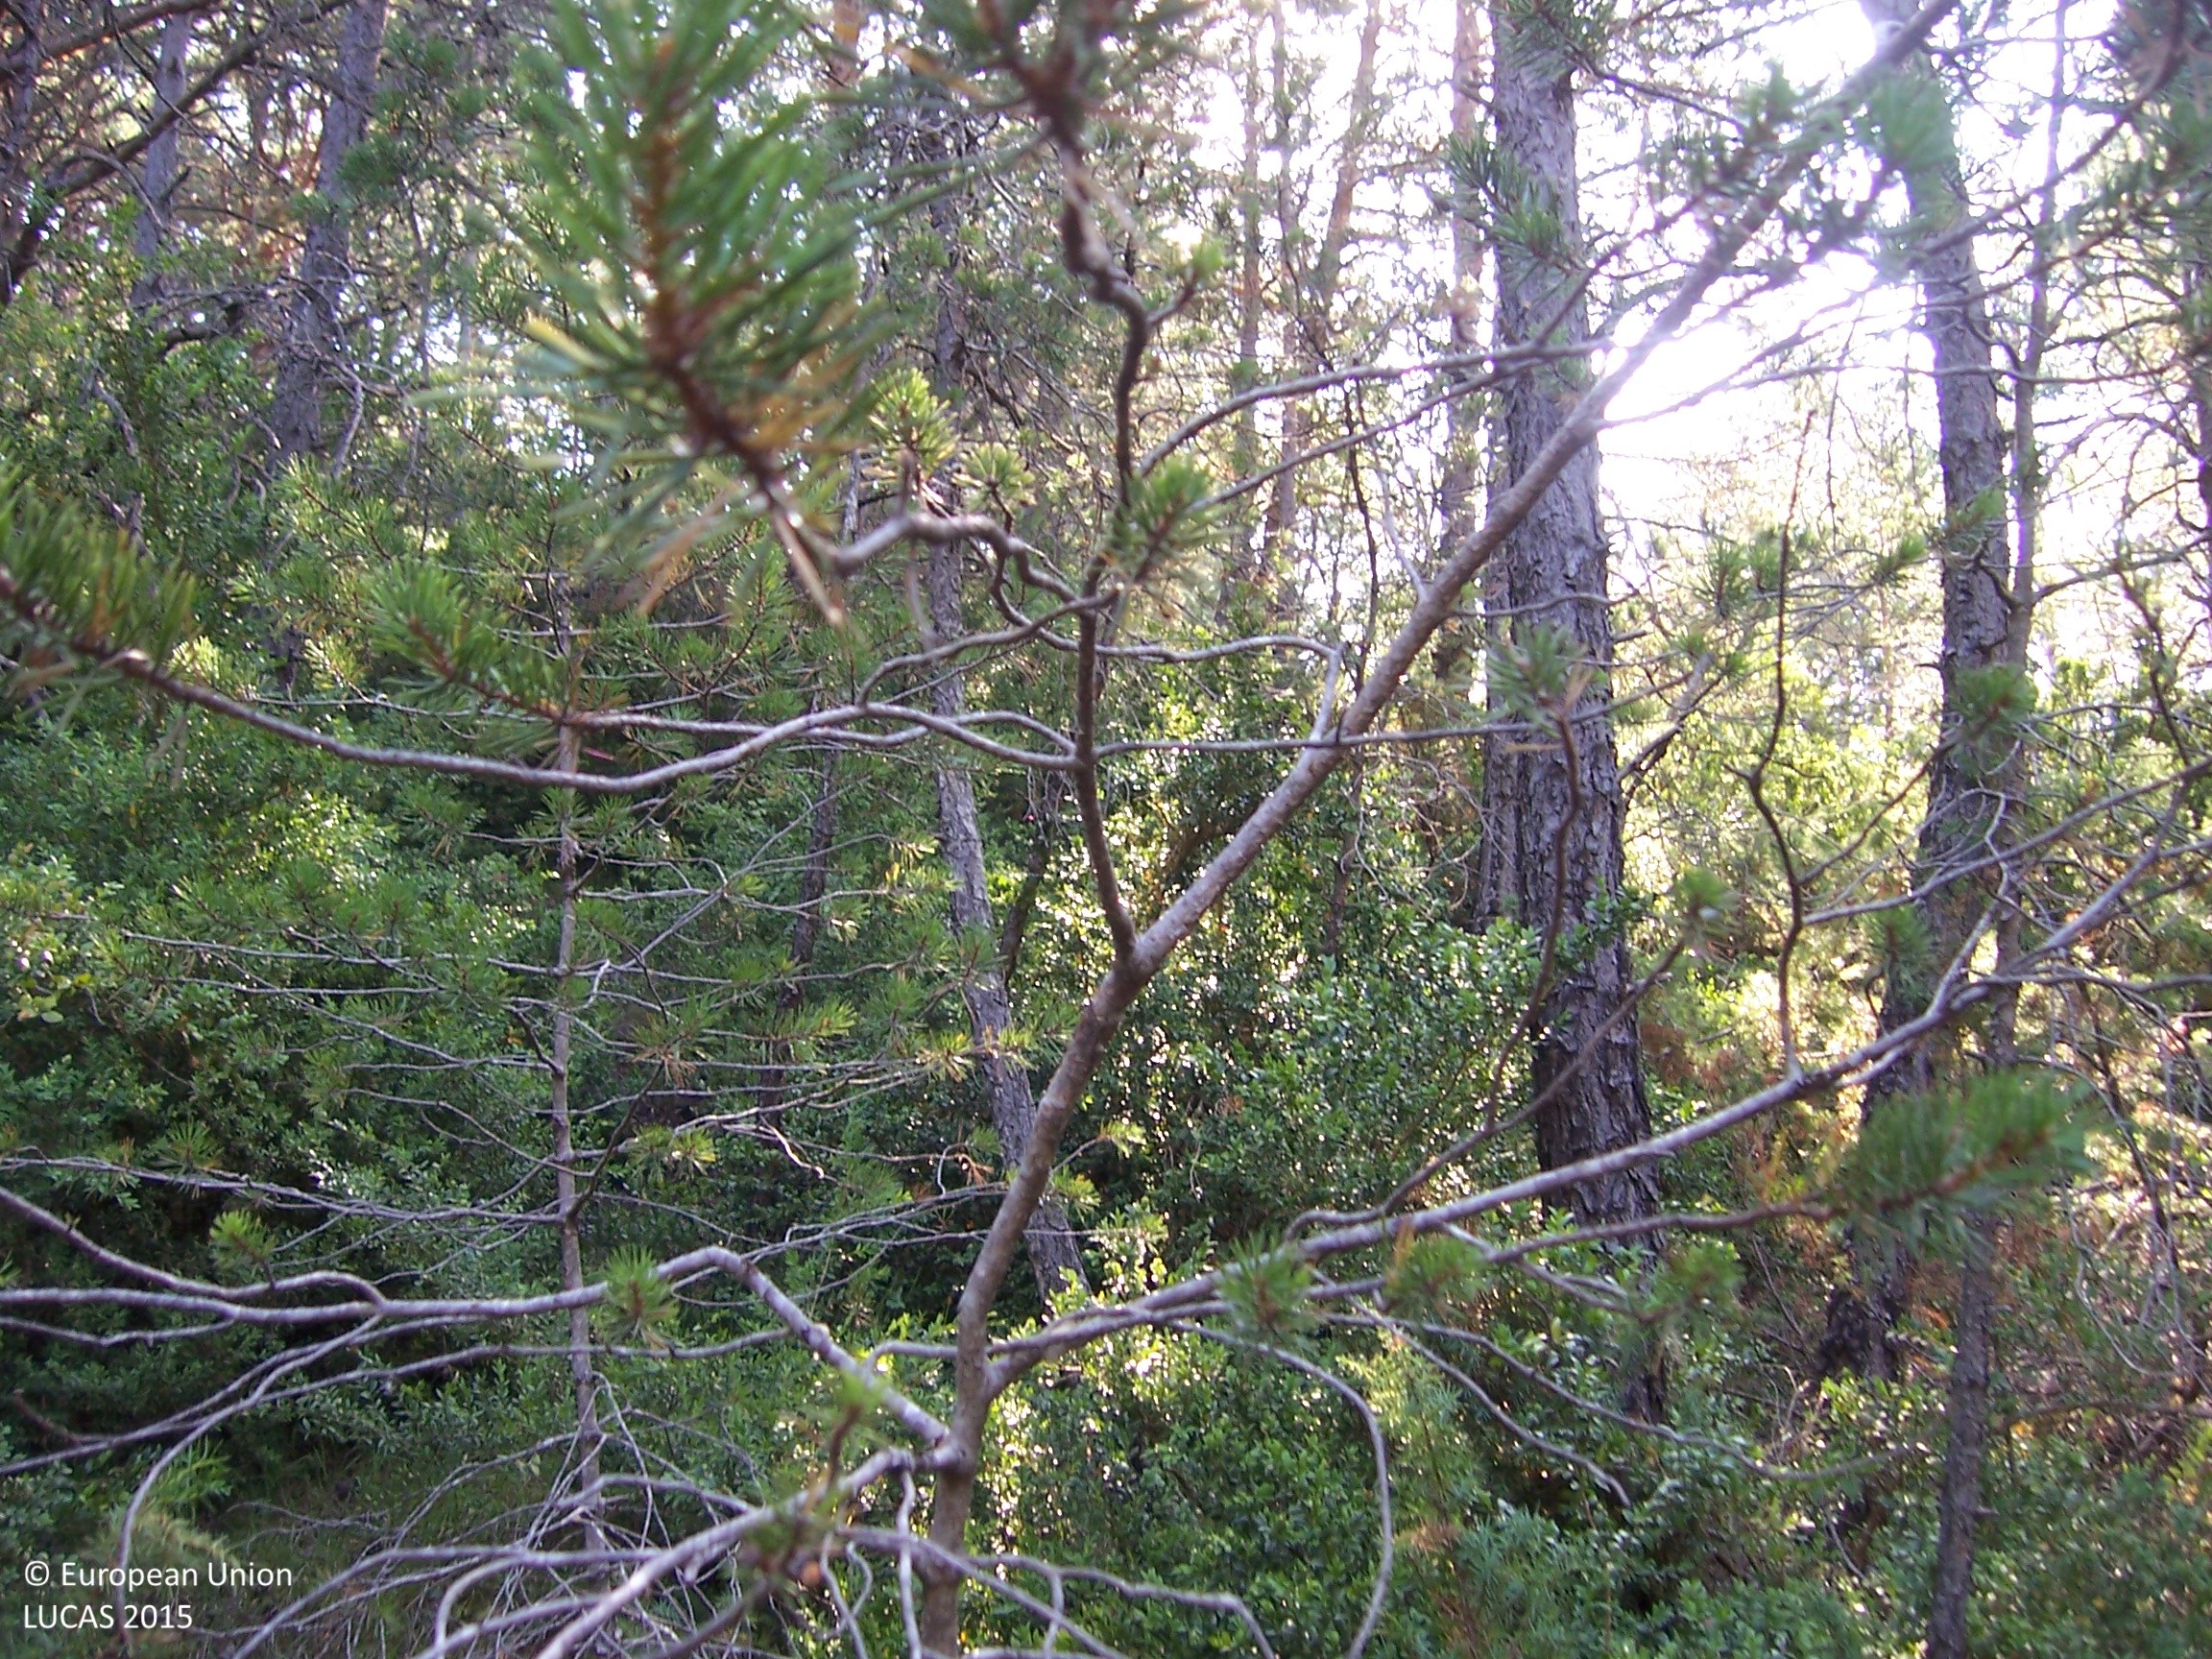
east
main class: Woodland
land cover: Pine dominated coniferous woodland
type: coniferous forest of the mediterranean region
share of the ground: > 75 %
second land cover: Grassland without tree/shrub cover
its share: < 10 %
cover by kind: coniferous forest trees 90 %, herbaceous plants 10 %
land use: Forestry
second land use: Agriculture (excluding fallow land and kitchen gardens)
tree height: > 5 m
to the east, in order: Pine dominated coniferous woodland; Grassland without tree/shrub cover; Fences; Grassland without tree/shrub cover; Fences; Pine dominated coniferous woodland
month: July
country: ES
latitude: 42.7782
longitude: -1.1938
